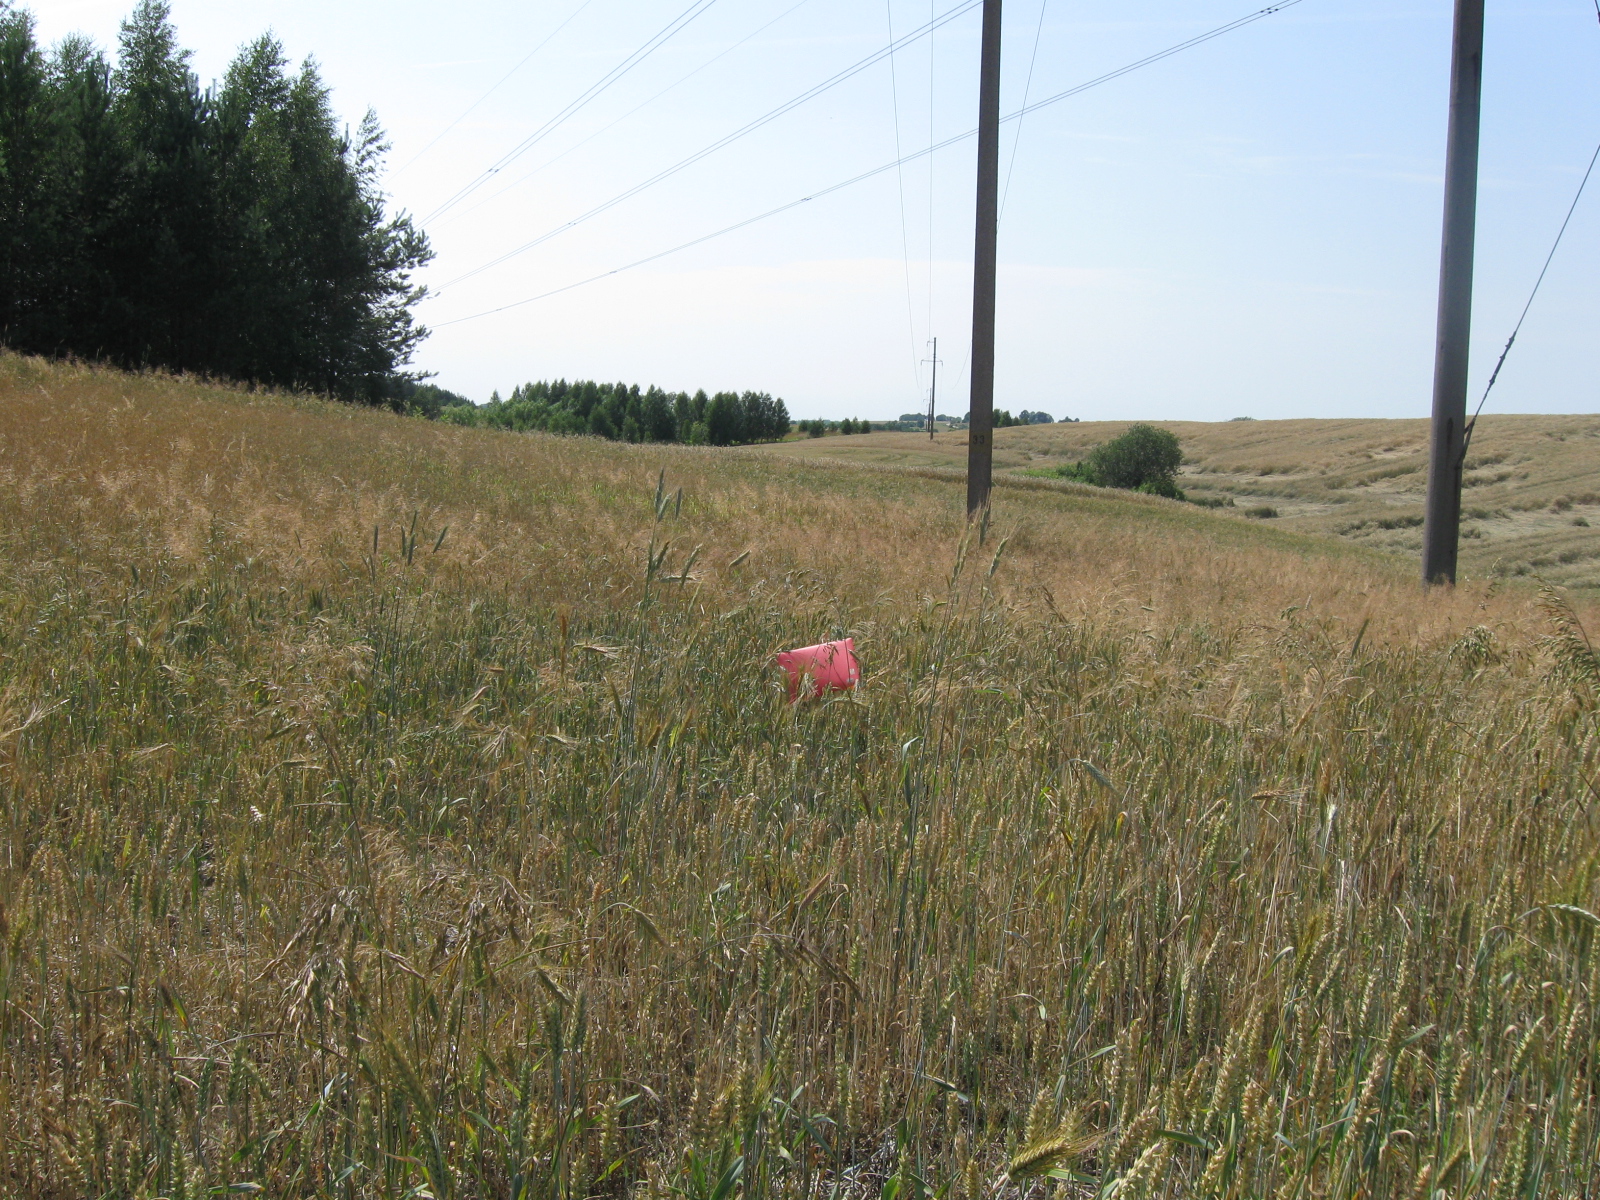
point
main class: Cropland
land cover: Common wheat
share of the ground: > 75 %
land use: Agriculture (excluding fallow land and kitchen gardens)
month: July
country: LT
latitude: 54.6761
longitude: 23.9075
